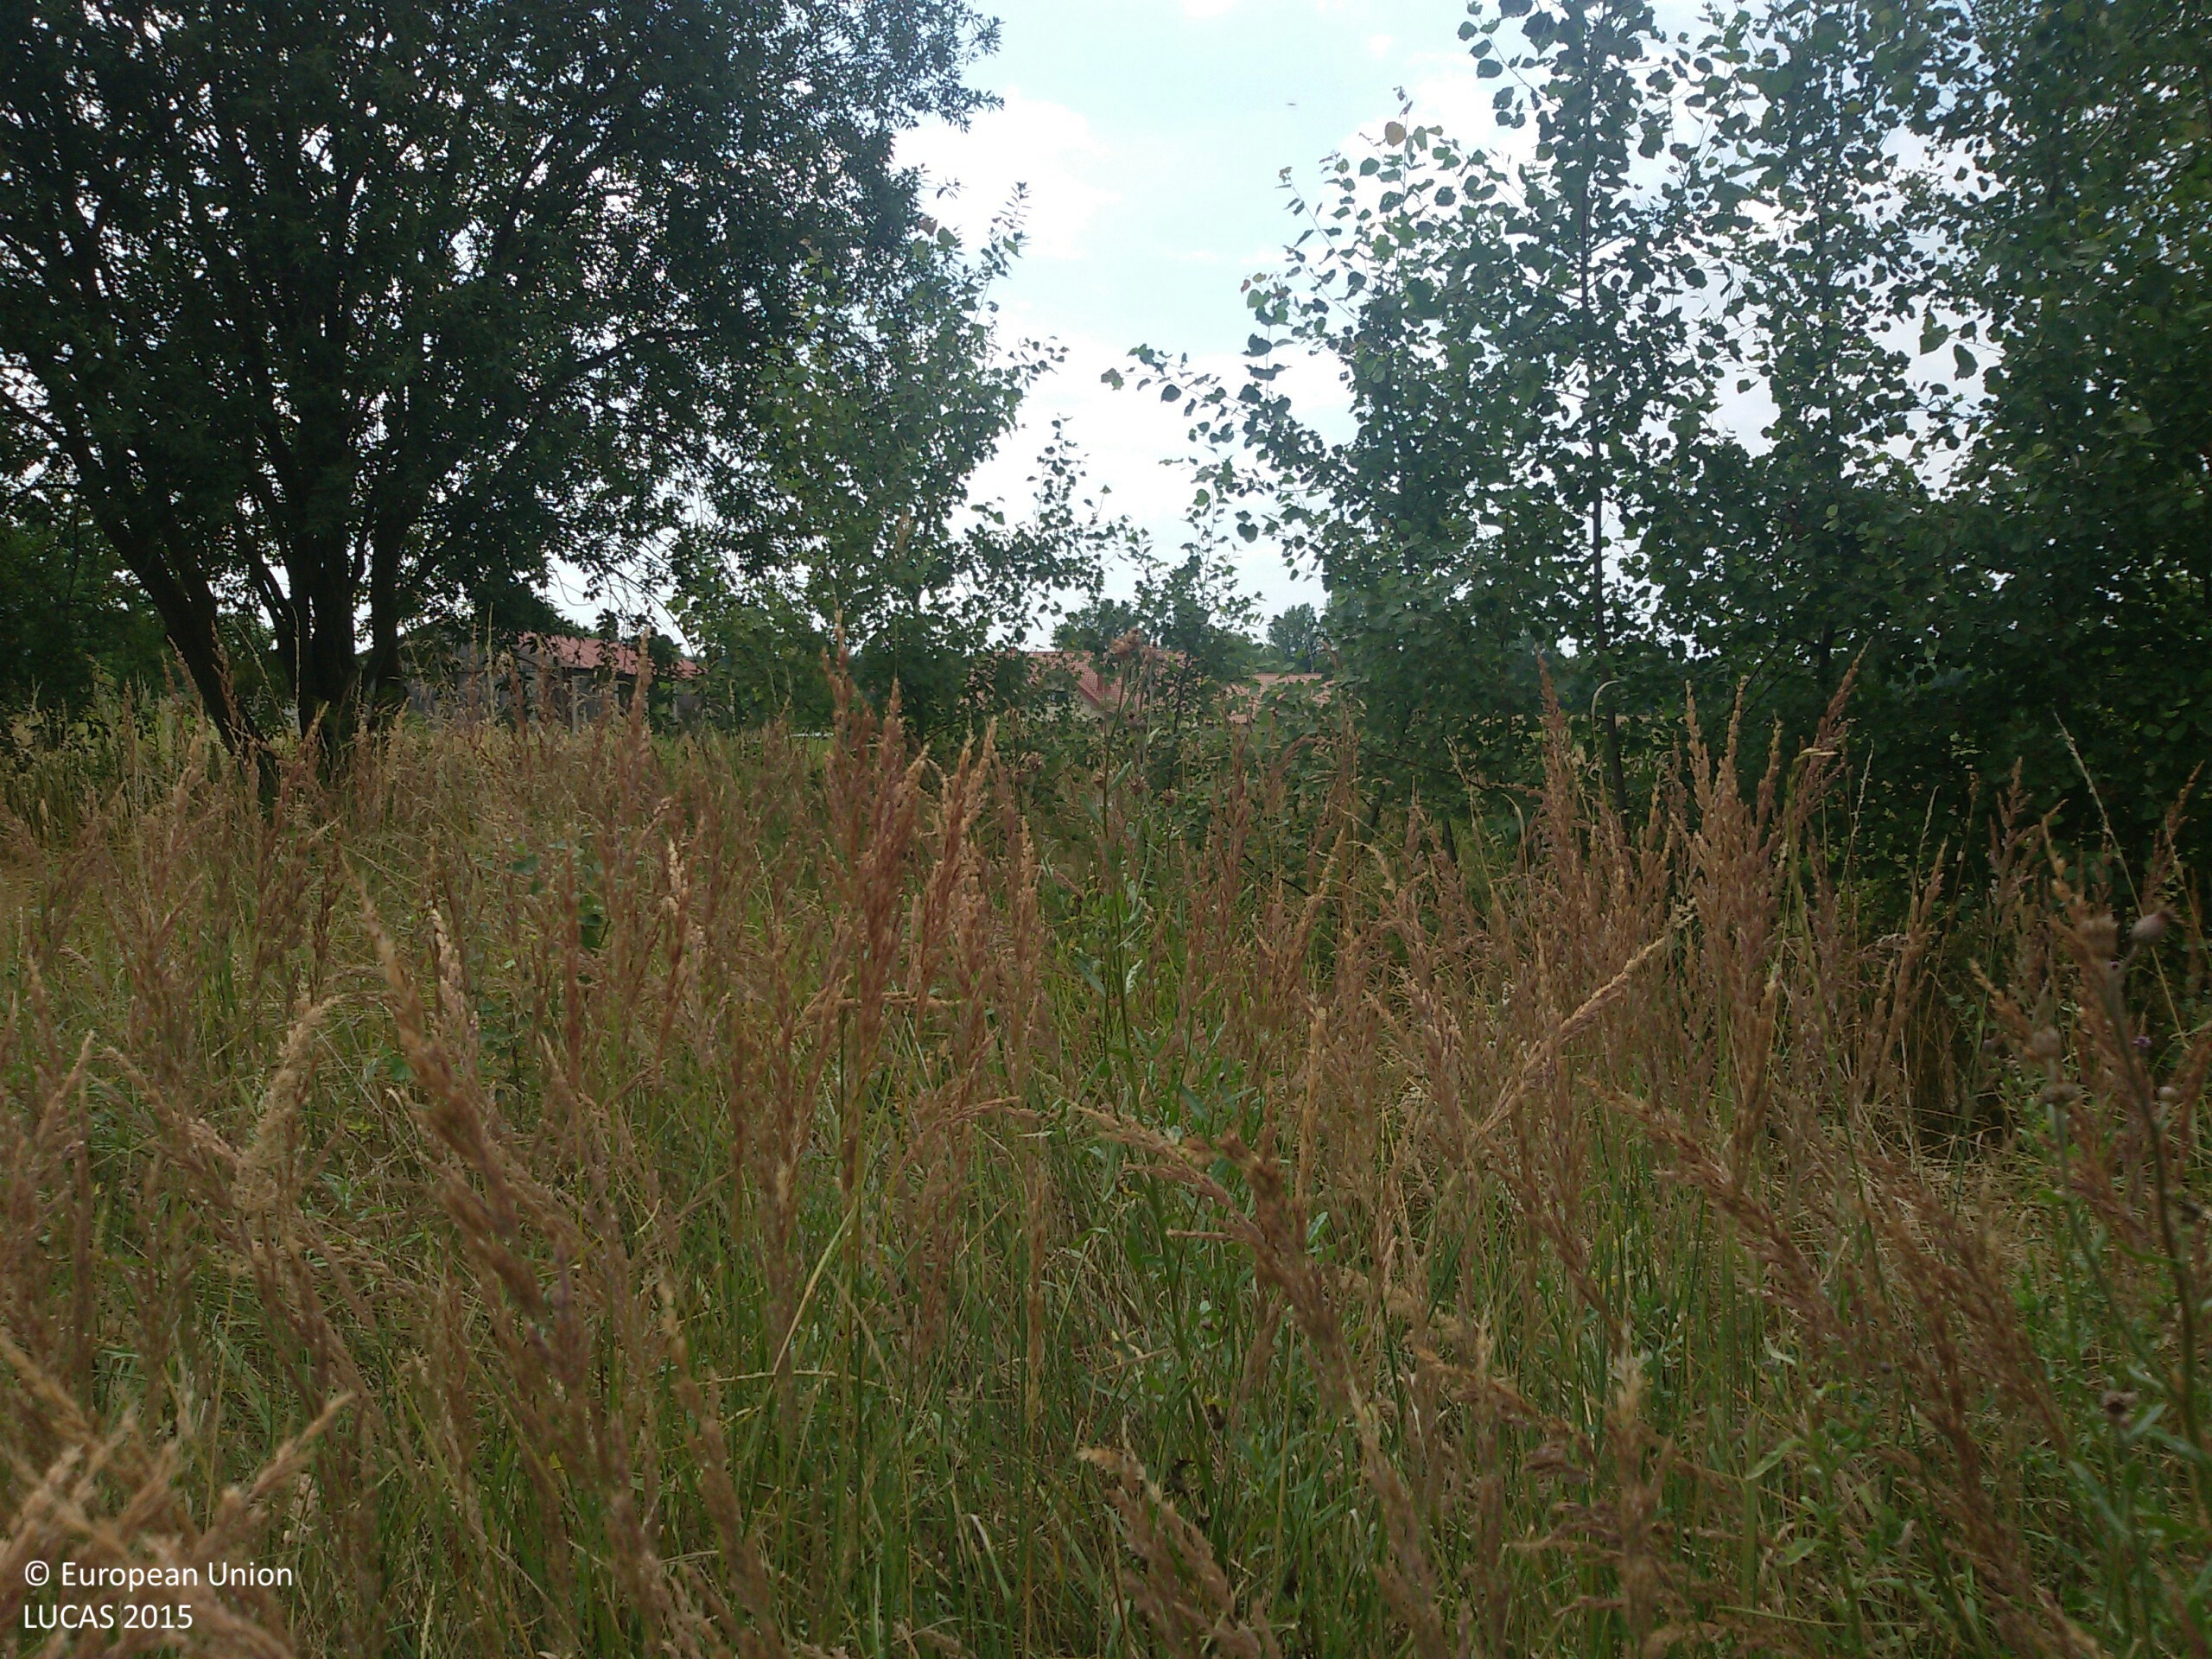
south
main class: Woodland
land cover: Broadleaved woodland
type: mesophytic deciduous forest
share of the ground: 10 - 25 %
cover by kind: herbaceous plants 85 %, broadleaved forest trees 15 %
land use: Abandoned areas
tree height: > 5 m
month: August
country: PL
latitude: 51.3231
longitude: 22.7414
